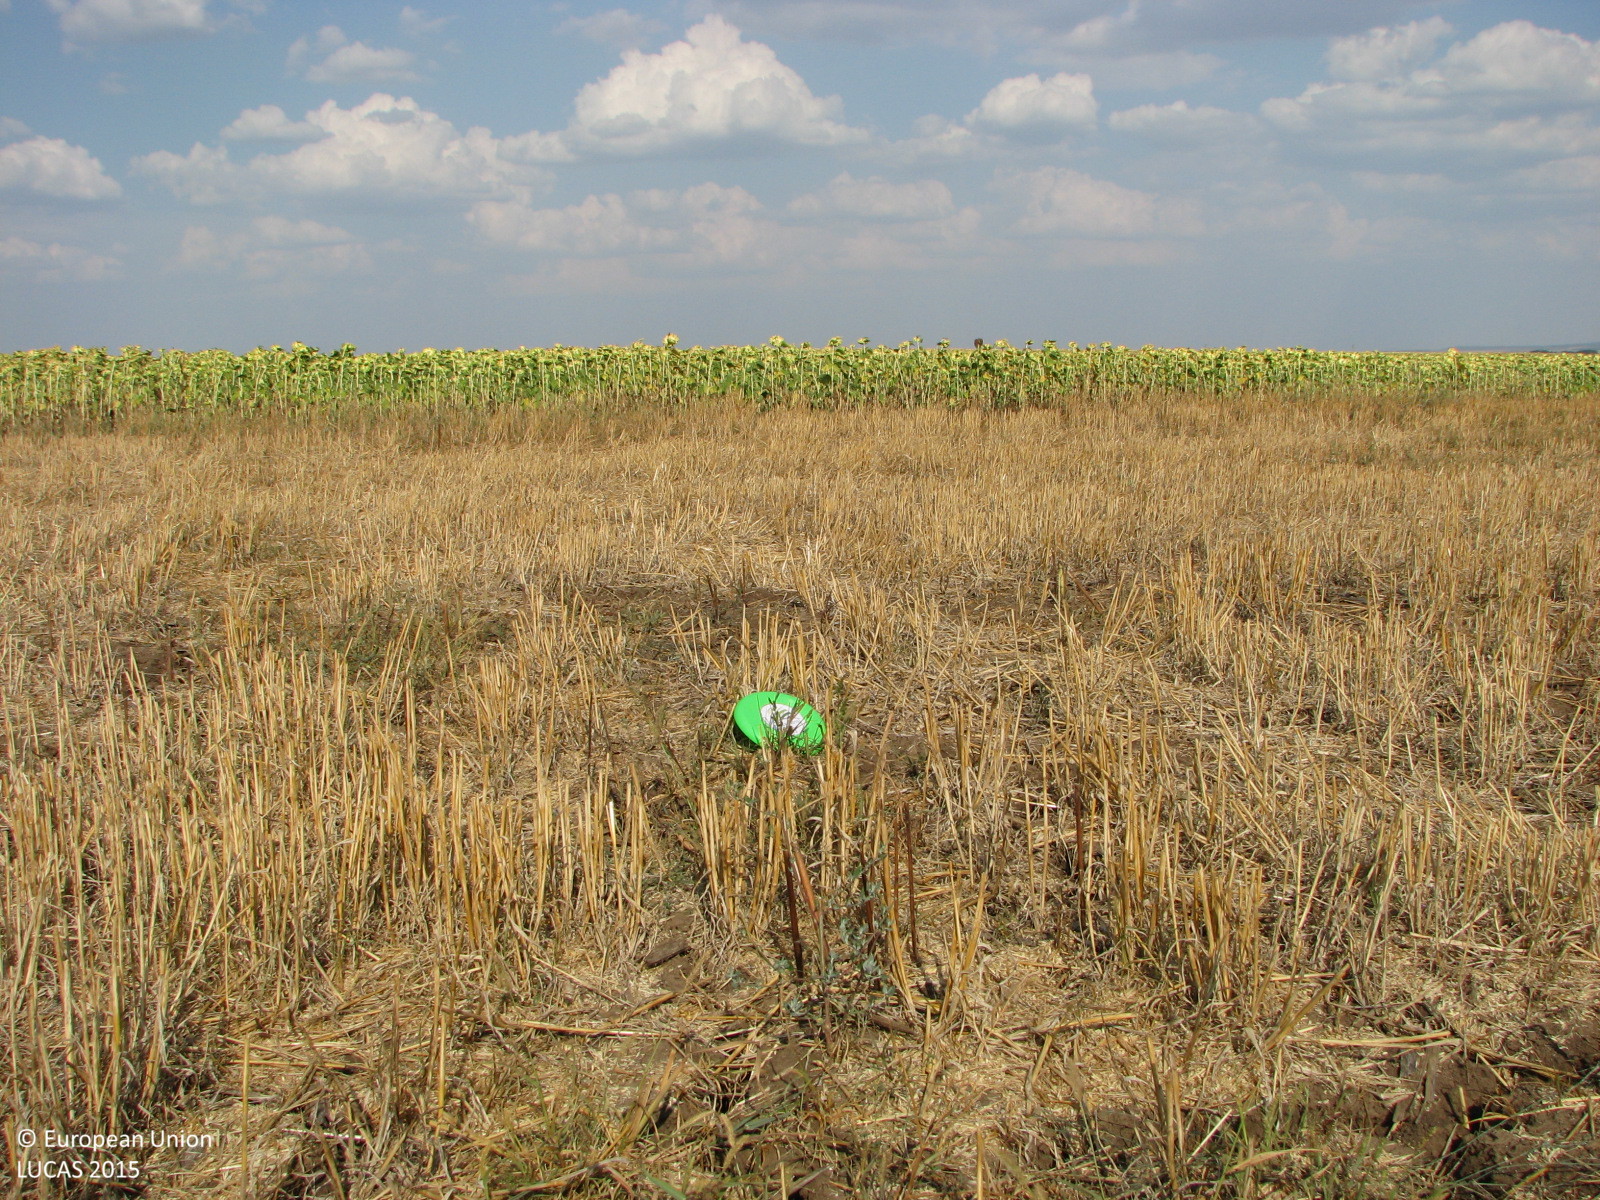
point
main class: Cropland
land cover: Common wheat
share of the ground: 25 - 50 %
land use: Agriculture (excluding fallow land and kitchen gardens)
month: August
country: BG
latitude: 42.5608
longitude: 26.5998
